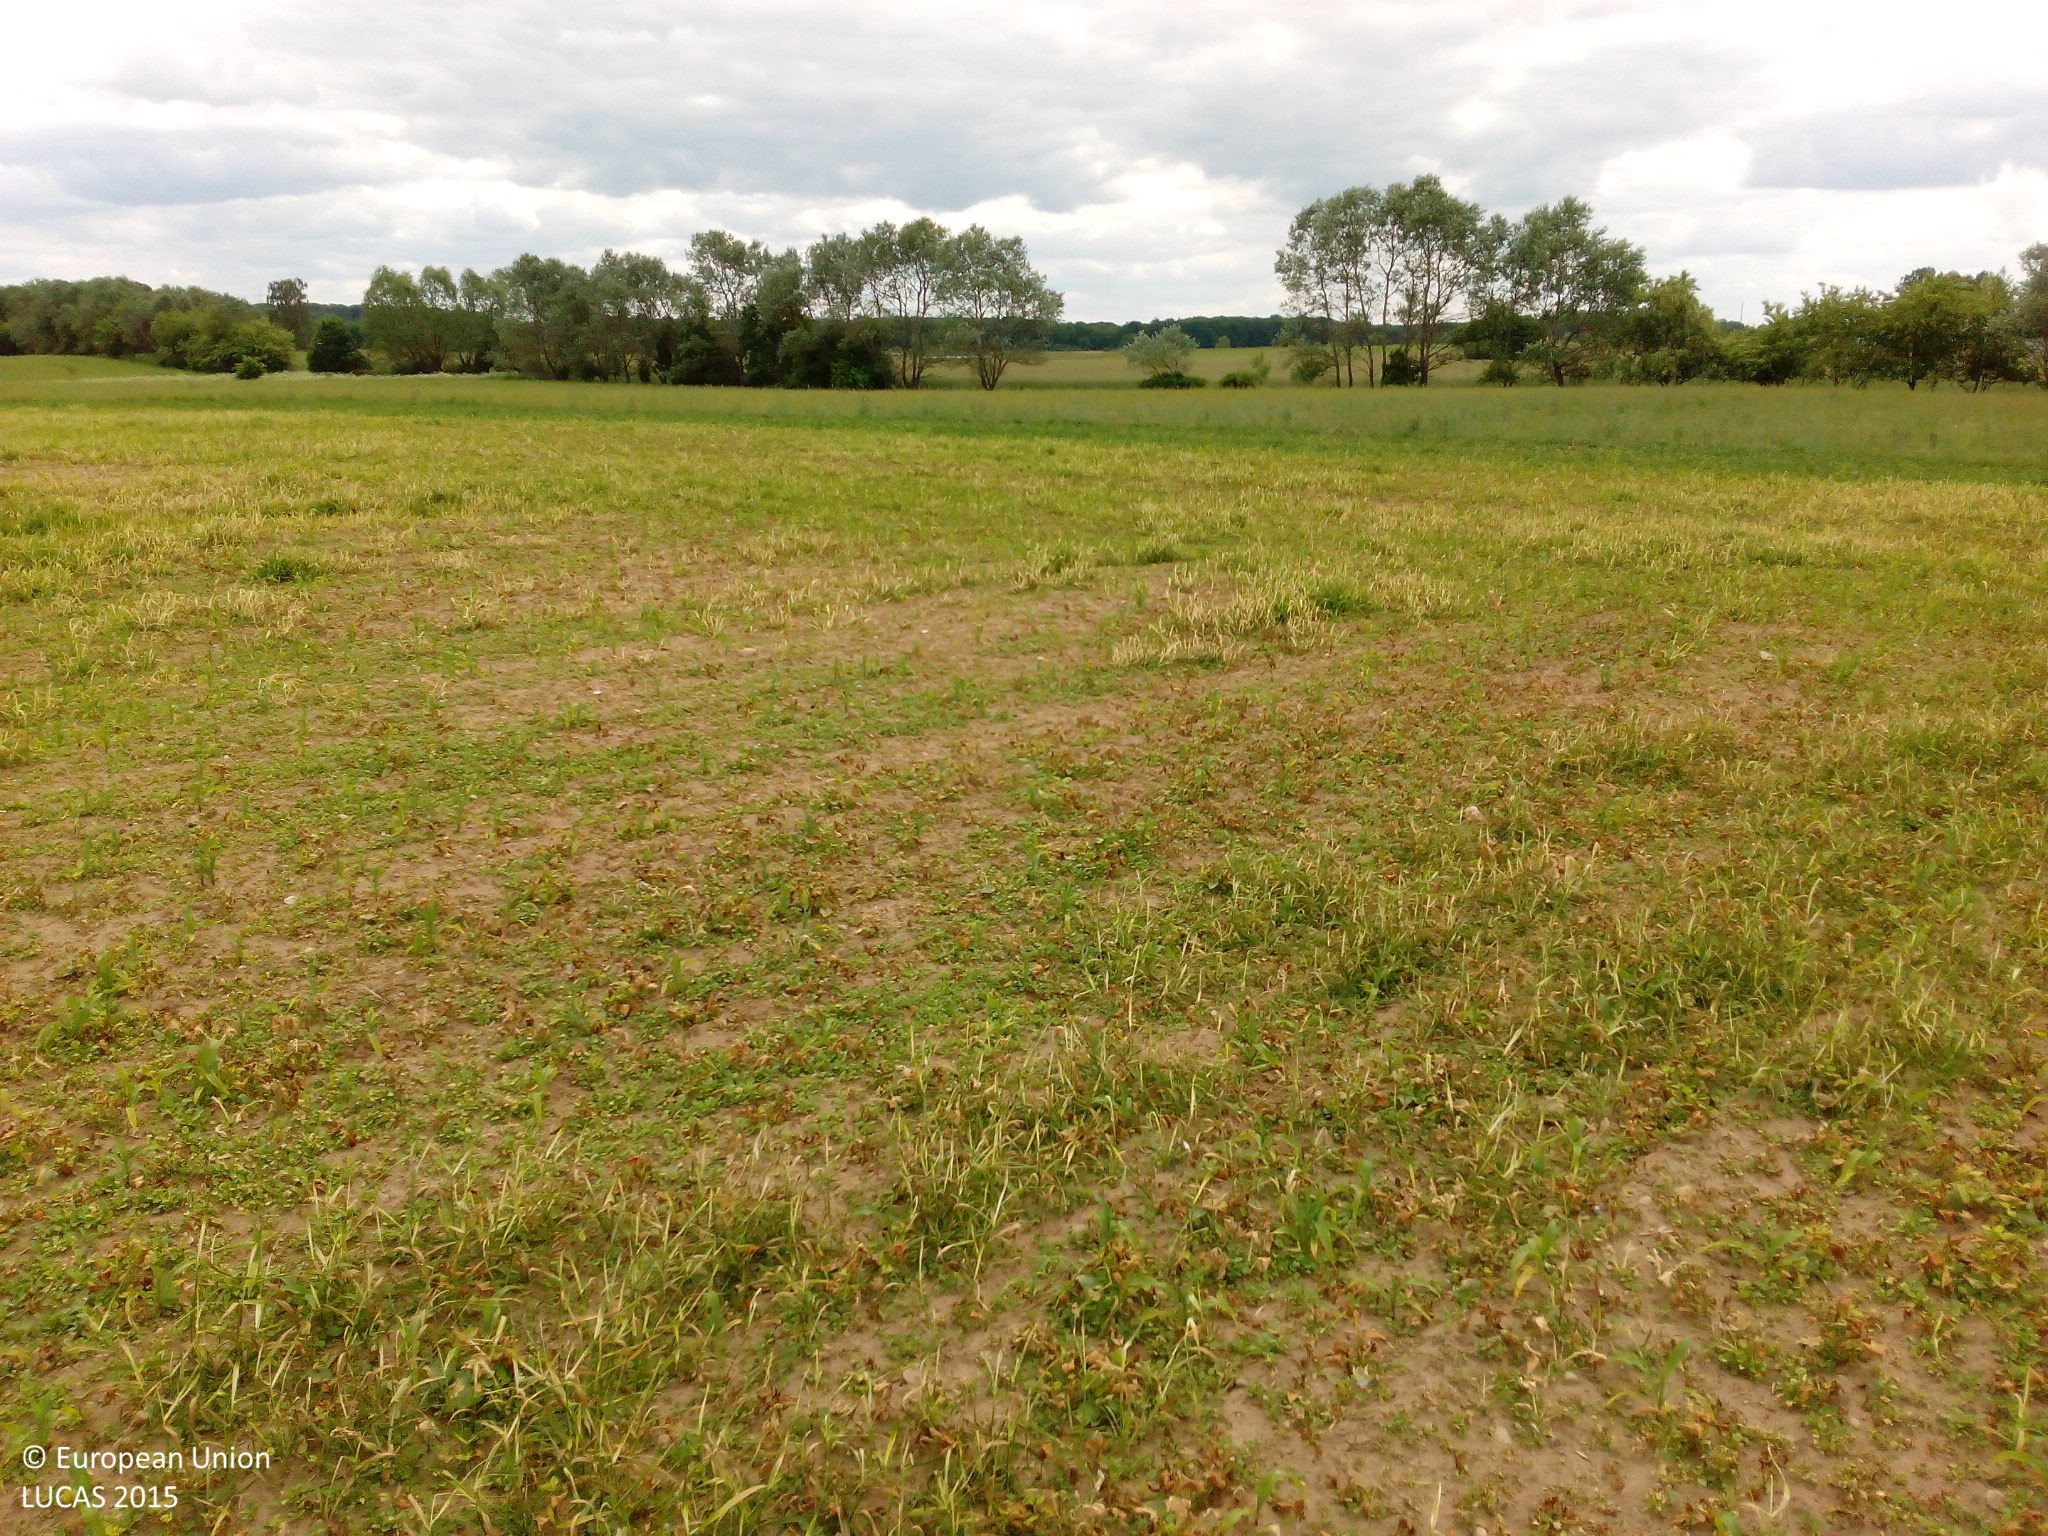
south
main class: Cropland
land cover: Maize
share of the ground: < 10 %
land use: Agriculture (excluding fallow land and kitchen gardens)
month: June
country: DE
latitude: 53.3969
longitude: 12.3604
